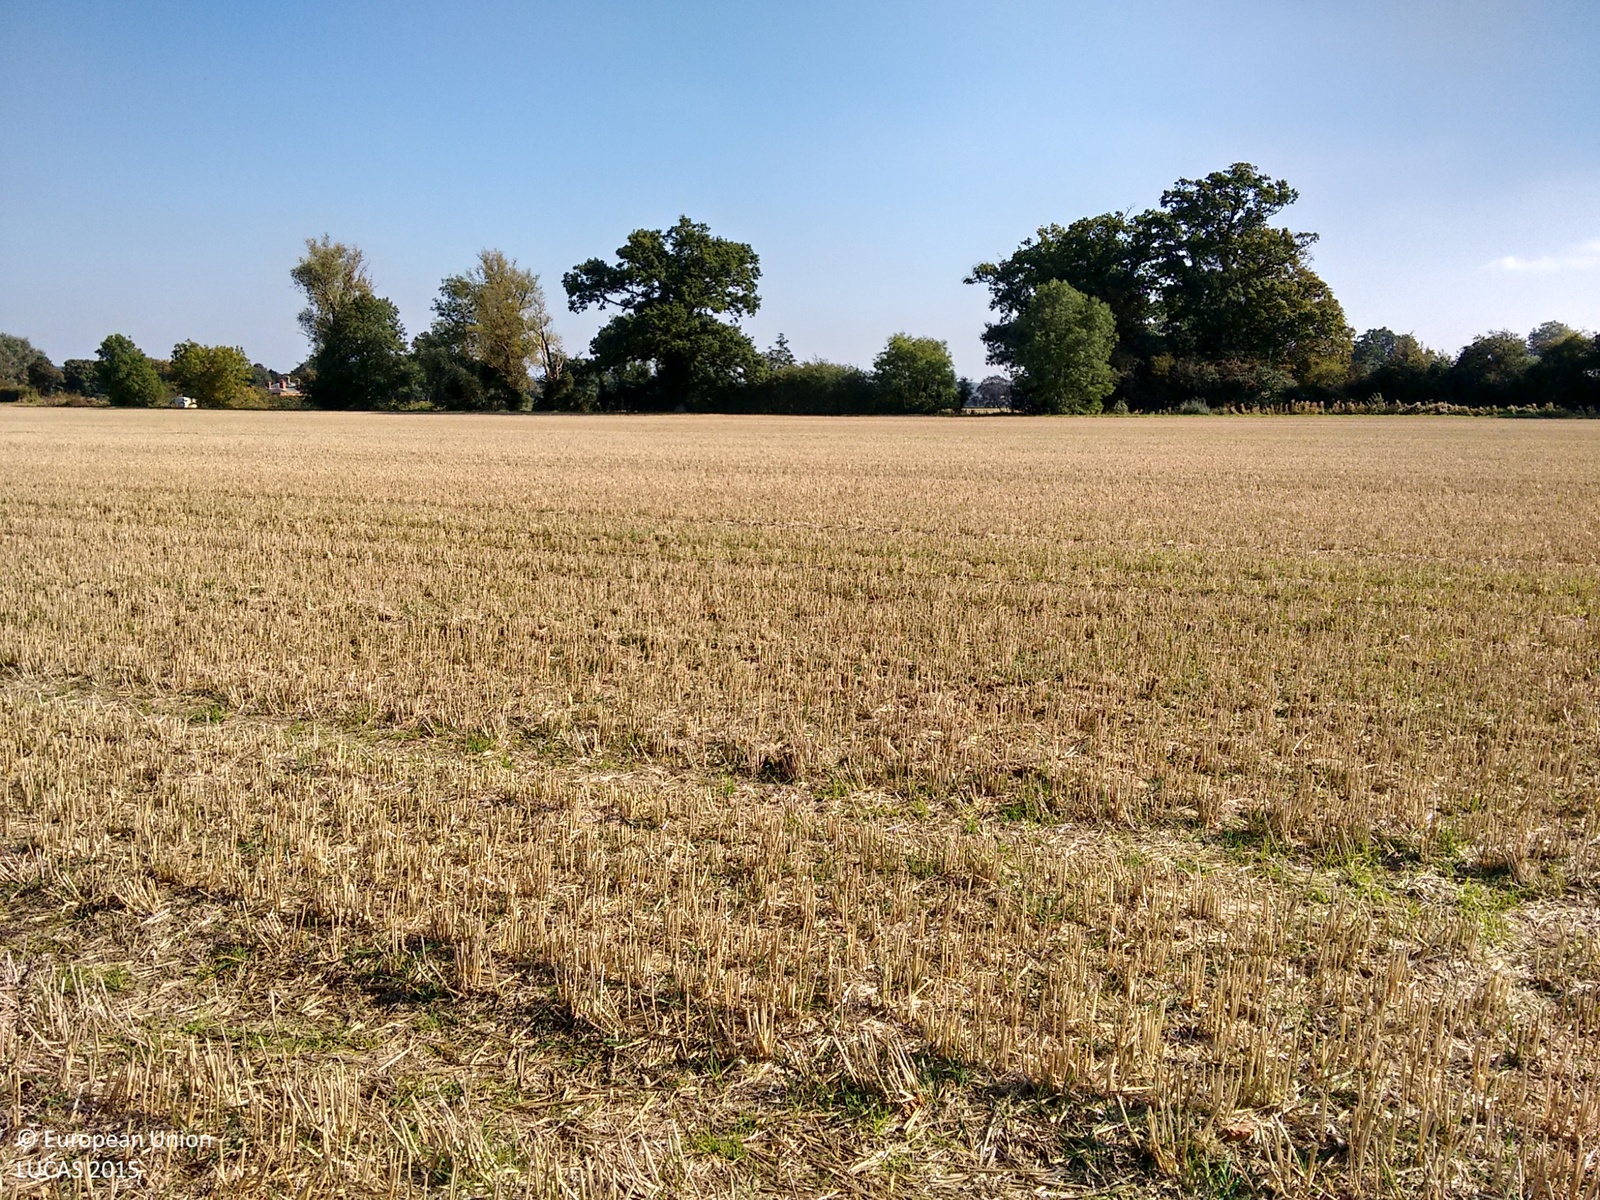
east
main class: Cropland
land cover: Common wheat
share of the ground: > 75 %
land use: Agriculture (excluding fallow land and kitchen gardens)
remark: Harvested field
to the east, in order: Common wheat; Grass margins; Tracks; Grass margins; Fences; Abandoned hedges; Grass margins; Common wheat
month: October
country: GB
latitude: 52.3410
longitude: 0.9792
